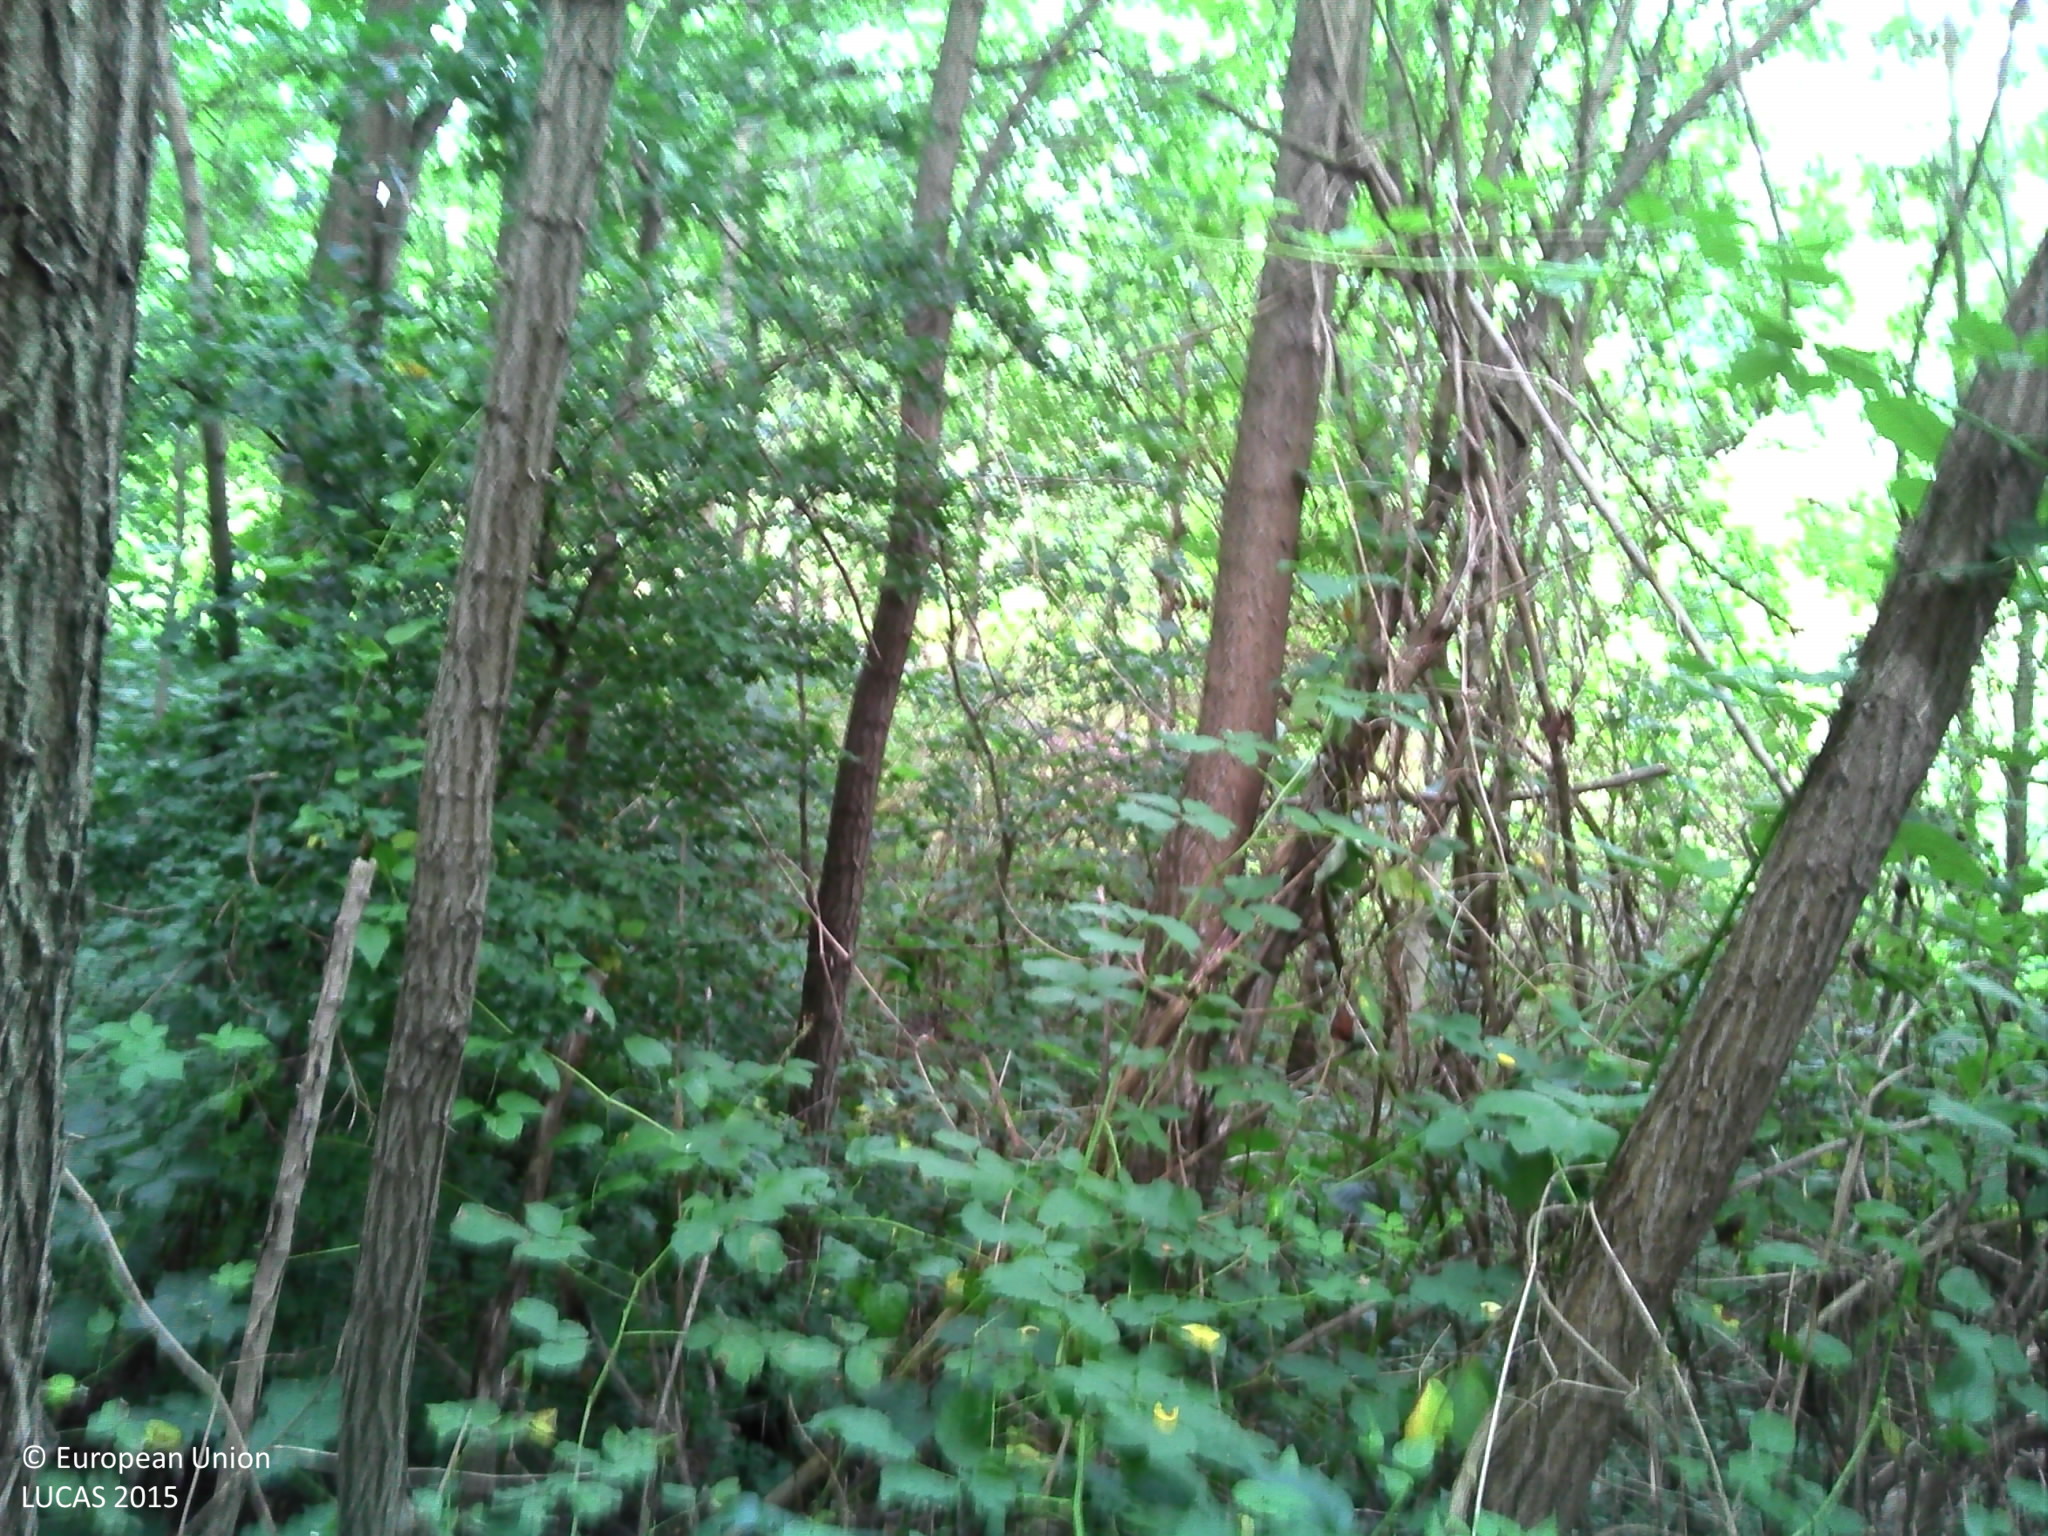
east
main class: Woodland
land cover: Broadleaved woodland
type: mesophytic deciduous forest
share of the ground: > 75 %
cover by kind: broadleaved forest trees 50 %, shrubs 40 %, herbaceous plants 5 %
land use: Semi-natural and natural areas not in use
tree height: > 5 m
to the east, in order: Broadleaved woodland; Tracks; Broadleaved woodland; Shrubland with sparse tree cover; Artificial constructions in urban areas
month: July
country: BE
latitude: 50.4269
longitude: 4.4354
